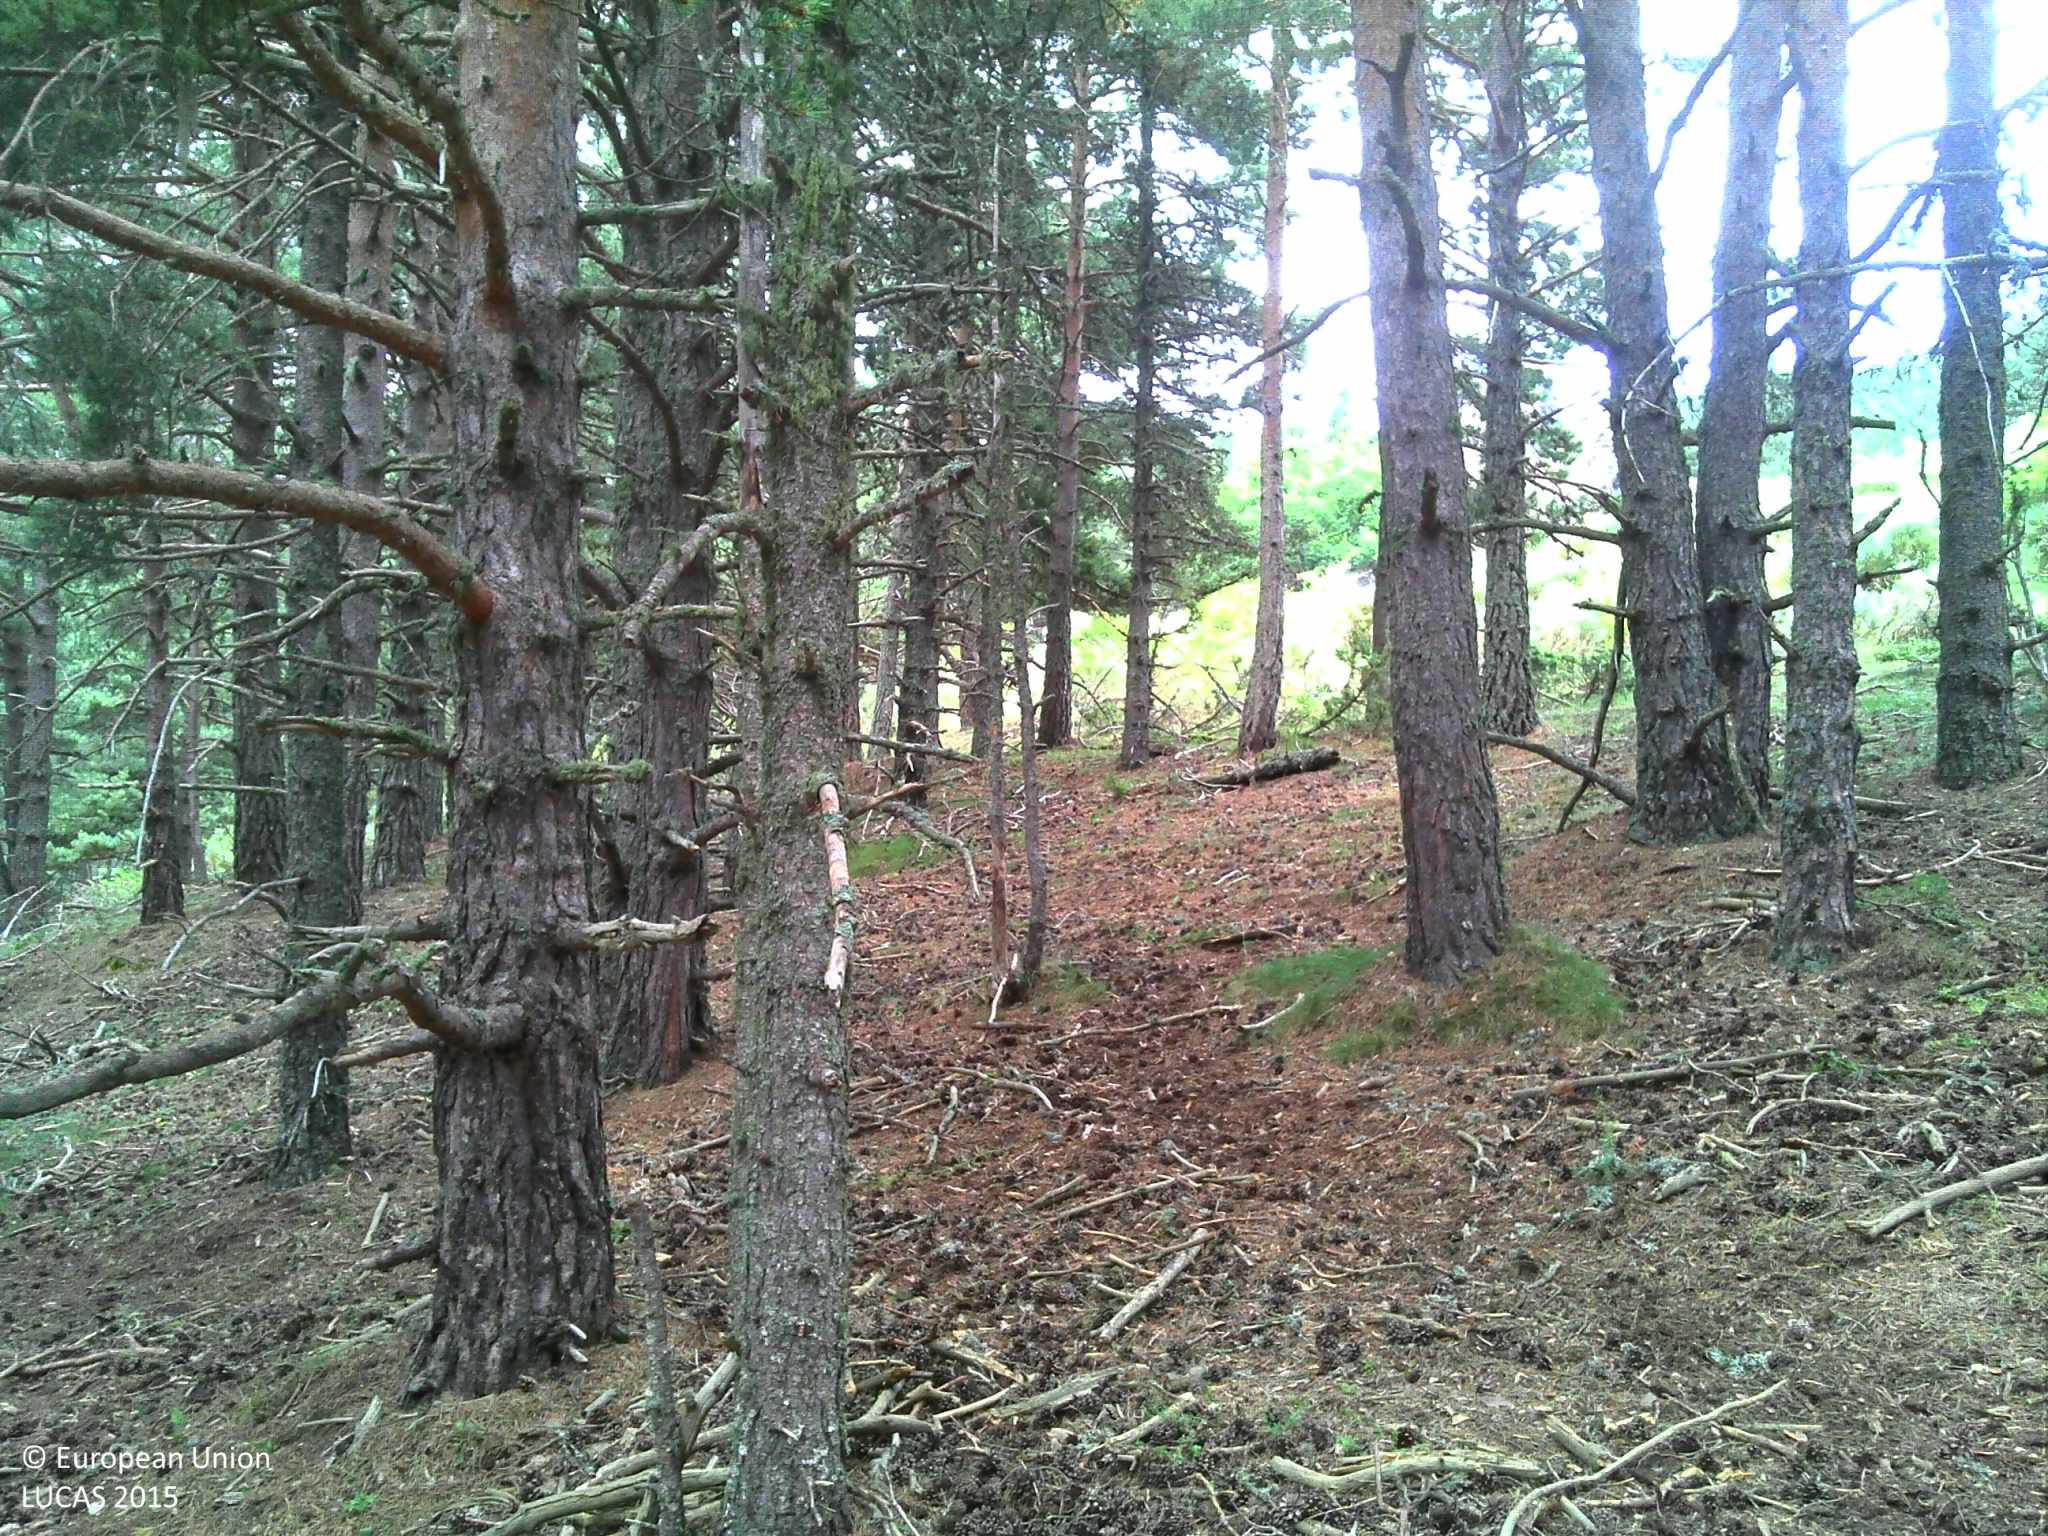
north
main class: Woodland
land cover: Pine dominated coniferous woodland
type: hemiboreal forest and nemoral coniferous forest and mixed broadleaved-coniferous forest
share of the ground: > 75 %
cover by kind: coniferous forest trees 80 %, shrubs 10 %, herbaceous plants 10 %
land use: Agriculture (excluding fallow land and kitchen gardens)
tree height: > 5 m
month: July
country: FR
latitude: 42.6029
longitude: 2.1492
